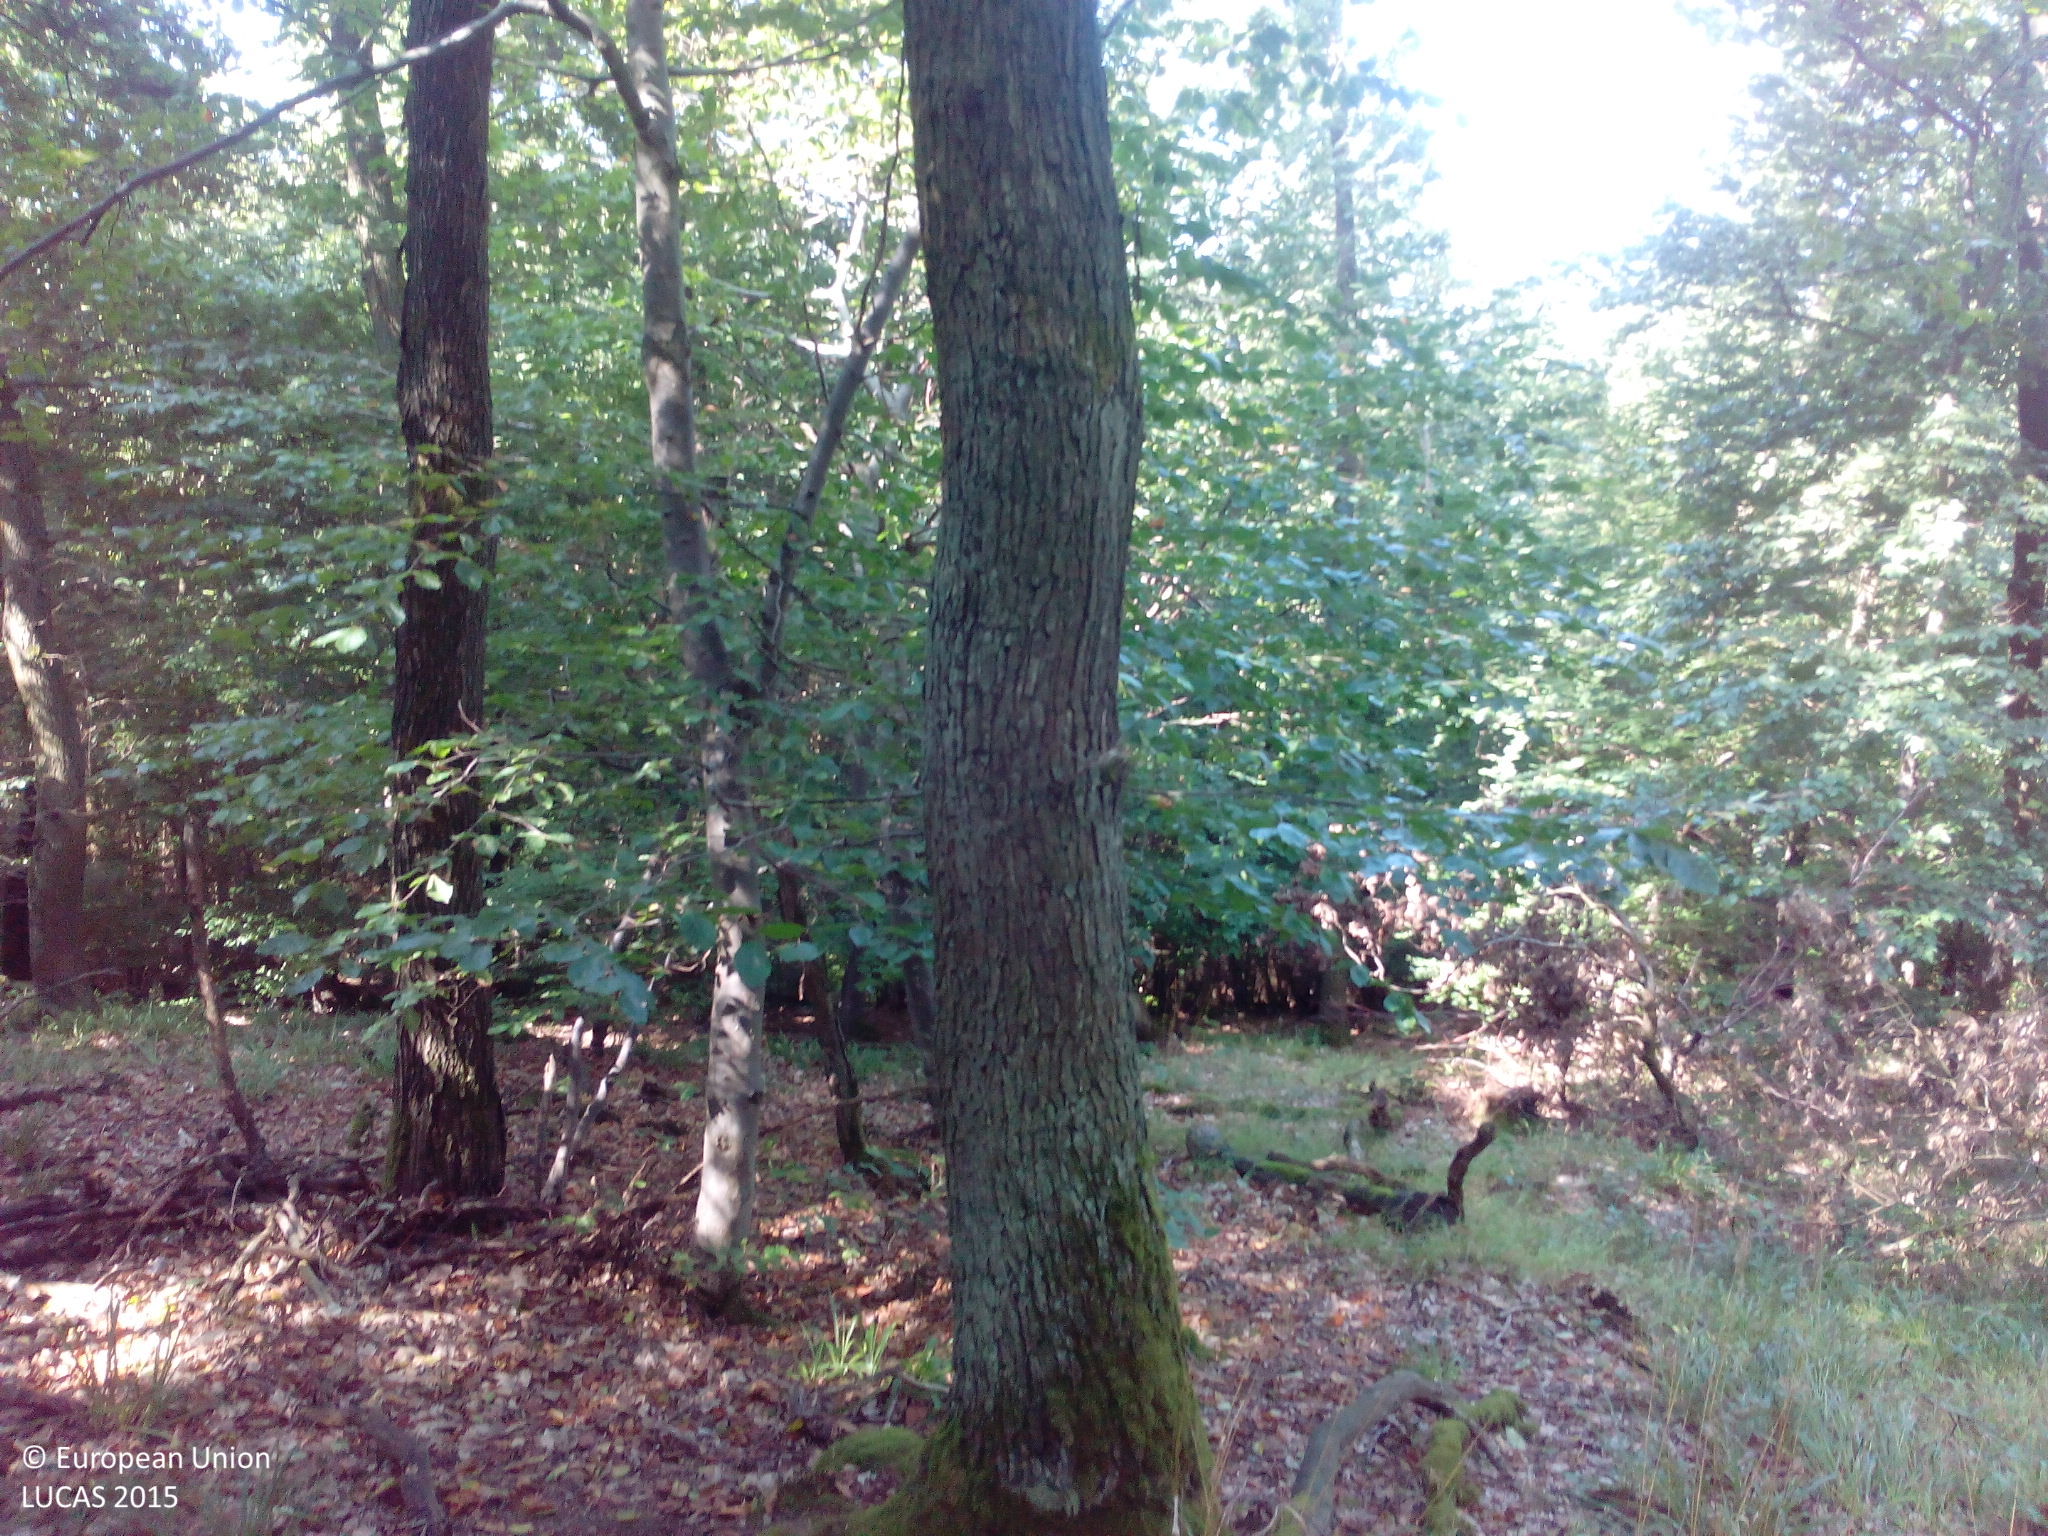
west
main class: Woodland
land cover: Broadleaved woodland
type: mesophytic deciduous forest
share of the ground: > 75 %
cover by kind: broadleaved forest trees 80 %, unconsolidated bare surface 10 %, herbaceous plants 5 %, lichens and mosses 5 %
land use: Forestry
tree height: > 5 m
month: August
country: DE
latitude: 50.2639
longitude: 7.4611
